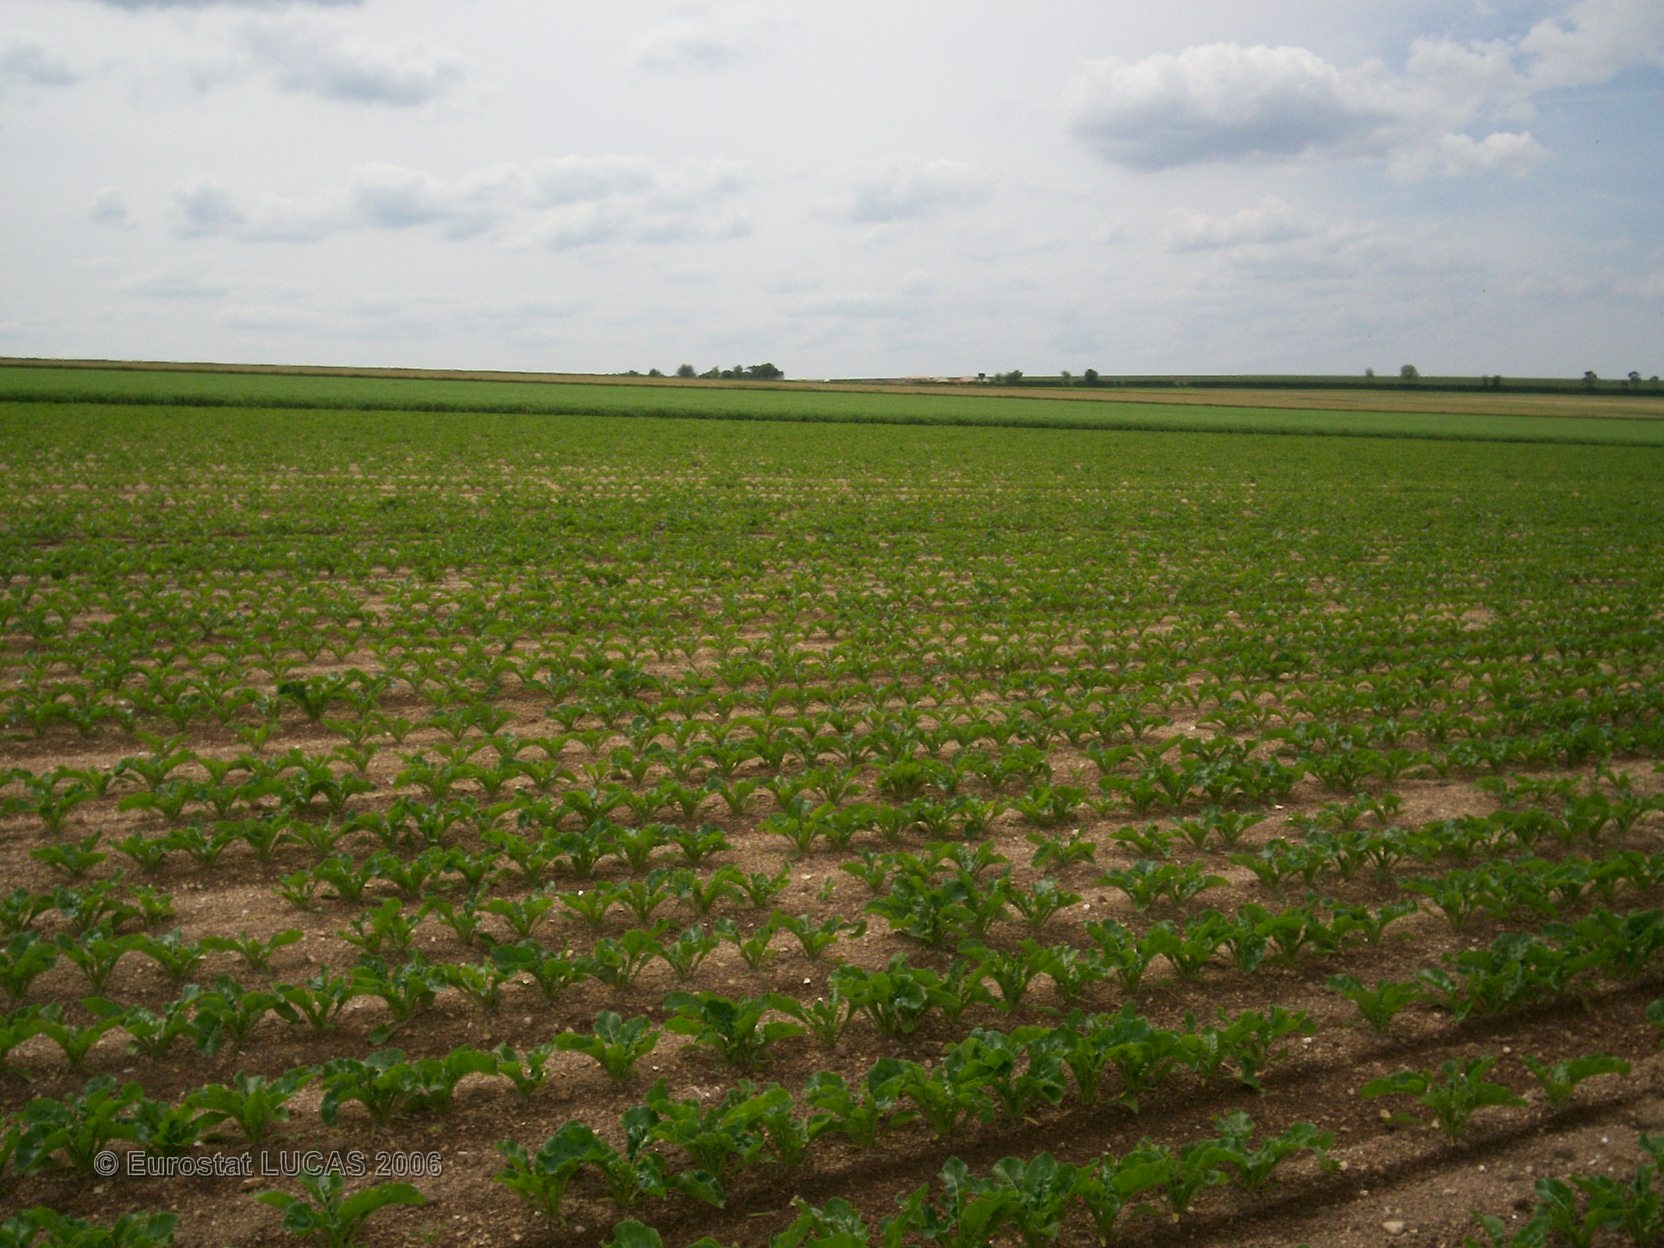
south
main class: Cropland
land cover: Rape and turnip rape
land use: Agriculture (excluding fallow land and kitchen gardens)
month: June
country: FR
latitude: 48.8851
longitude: 4.6103
